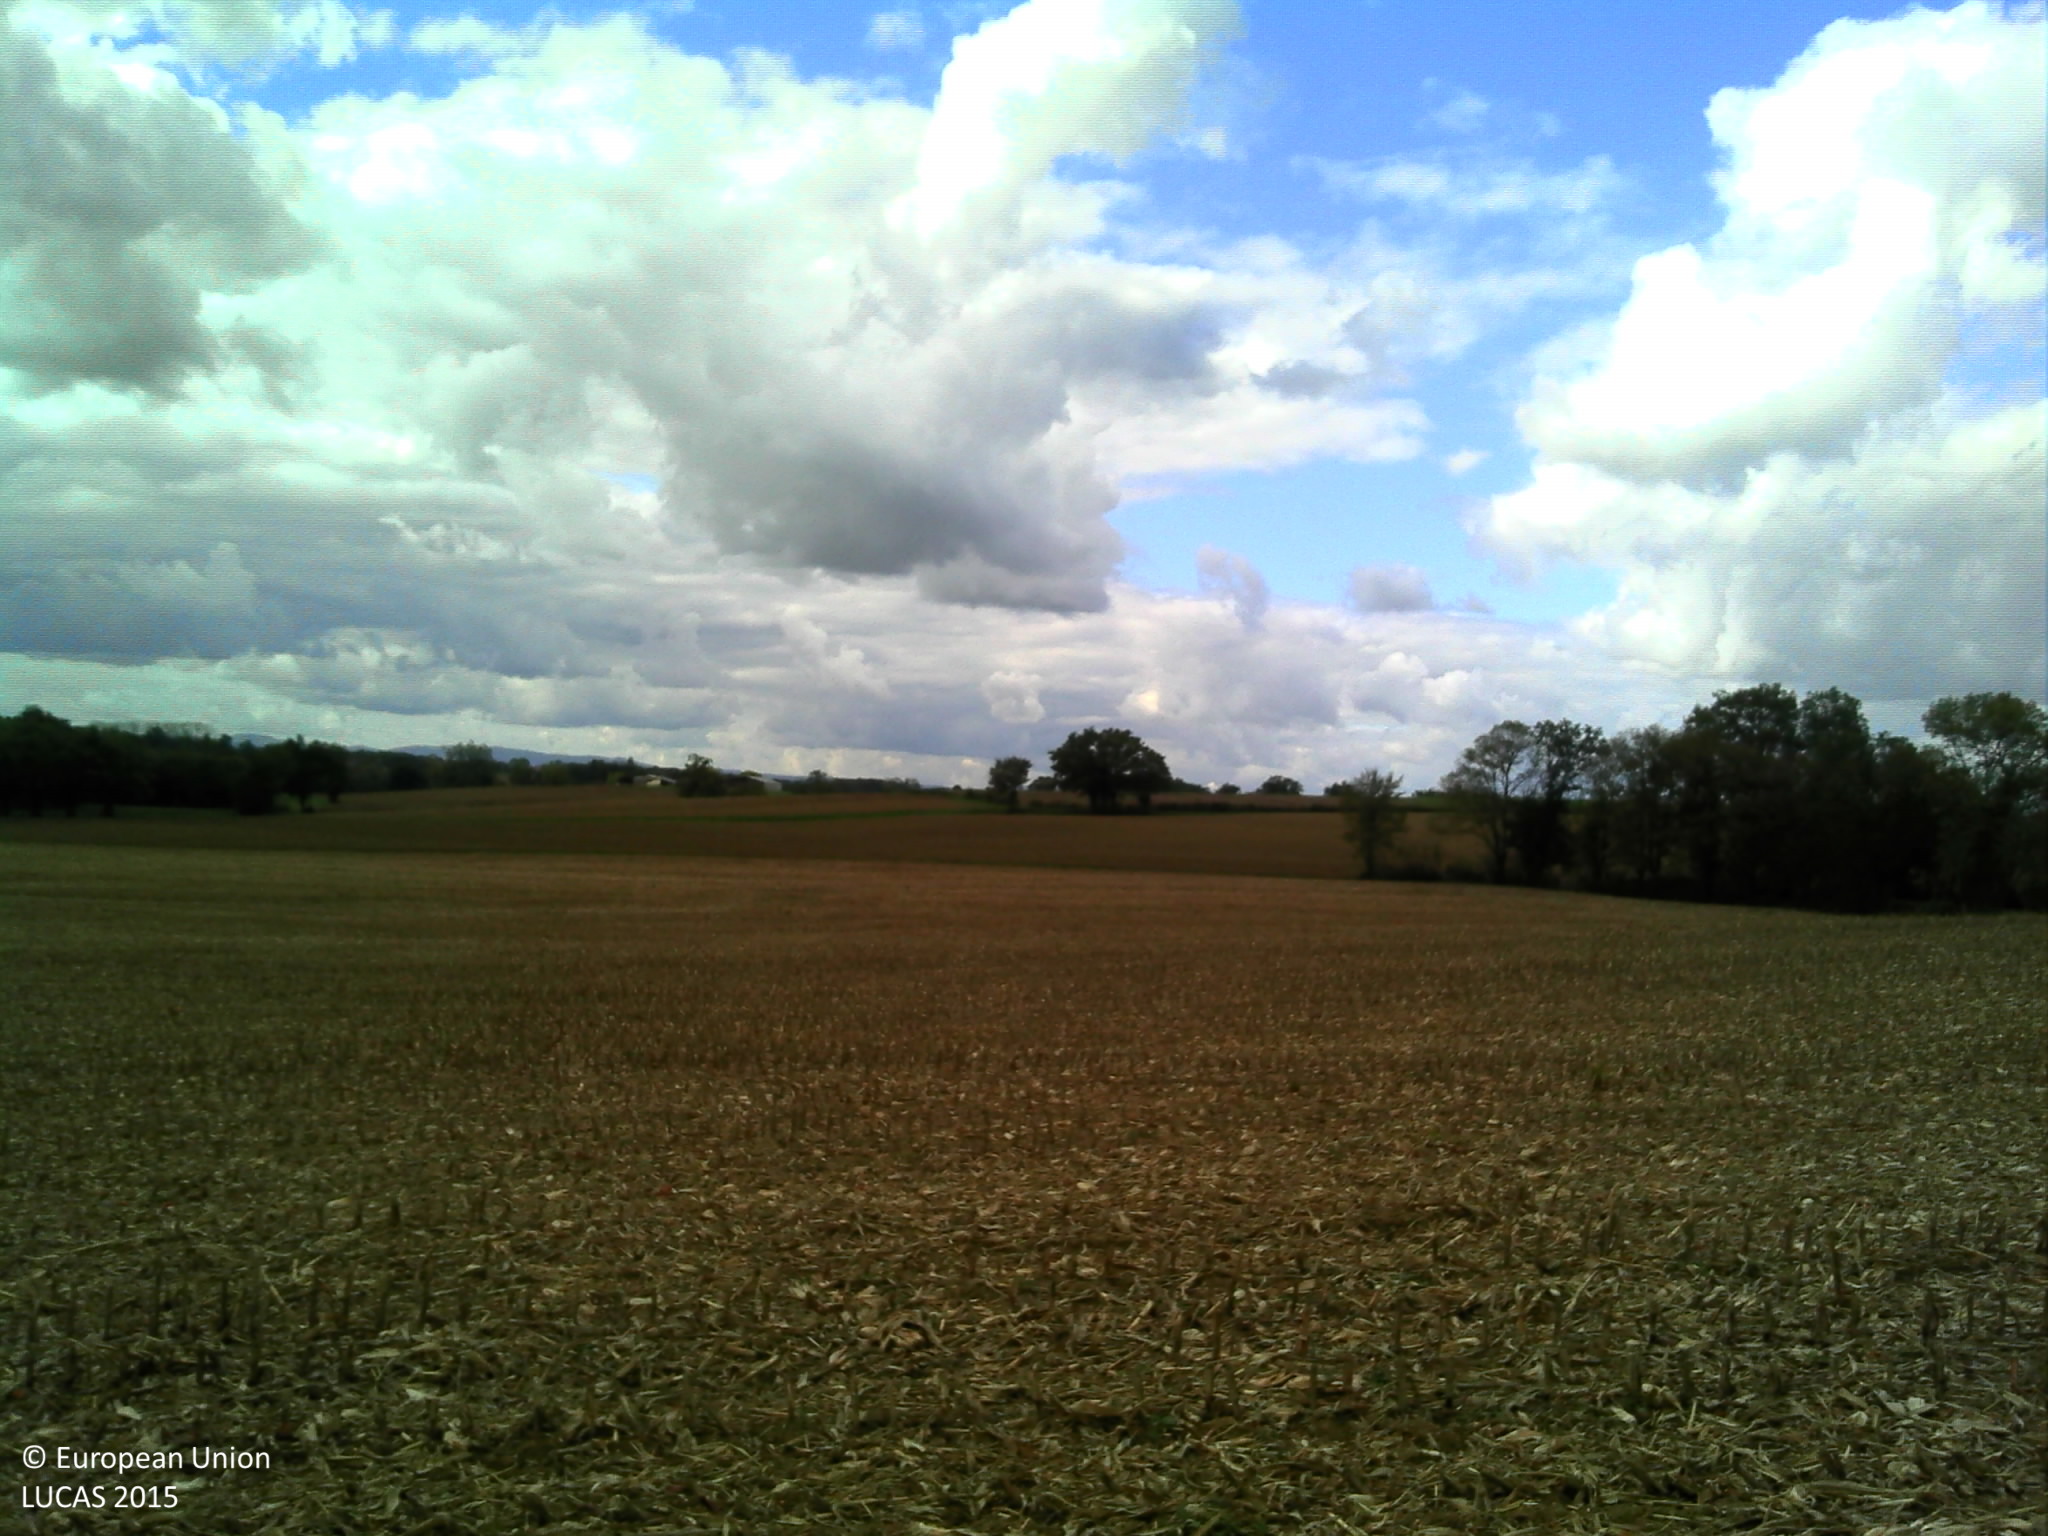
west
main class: Cropland
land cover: Maize
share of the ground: < 10 %
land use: Agriculture (excluding fallow land and kitchen gardens)
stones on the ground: < 10 %
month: October
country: FR
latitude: 46.3606
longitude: 4.9985
